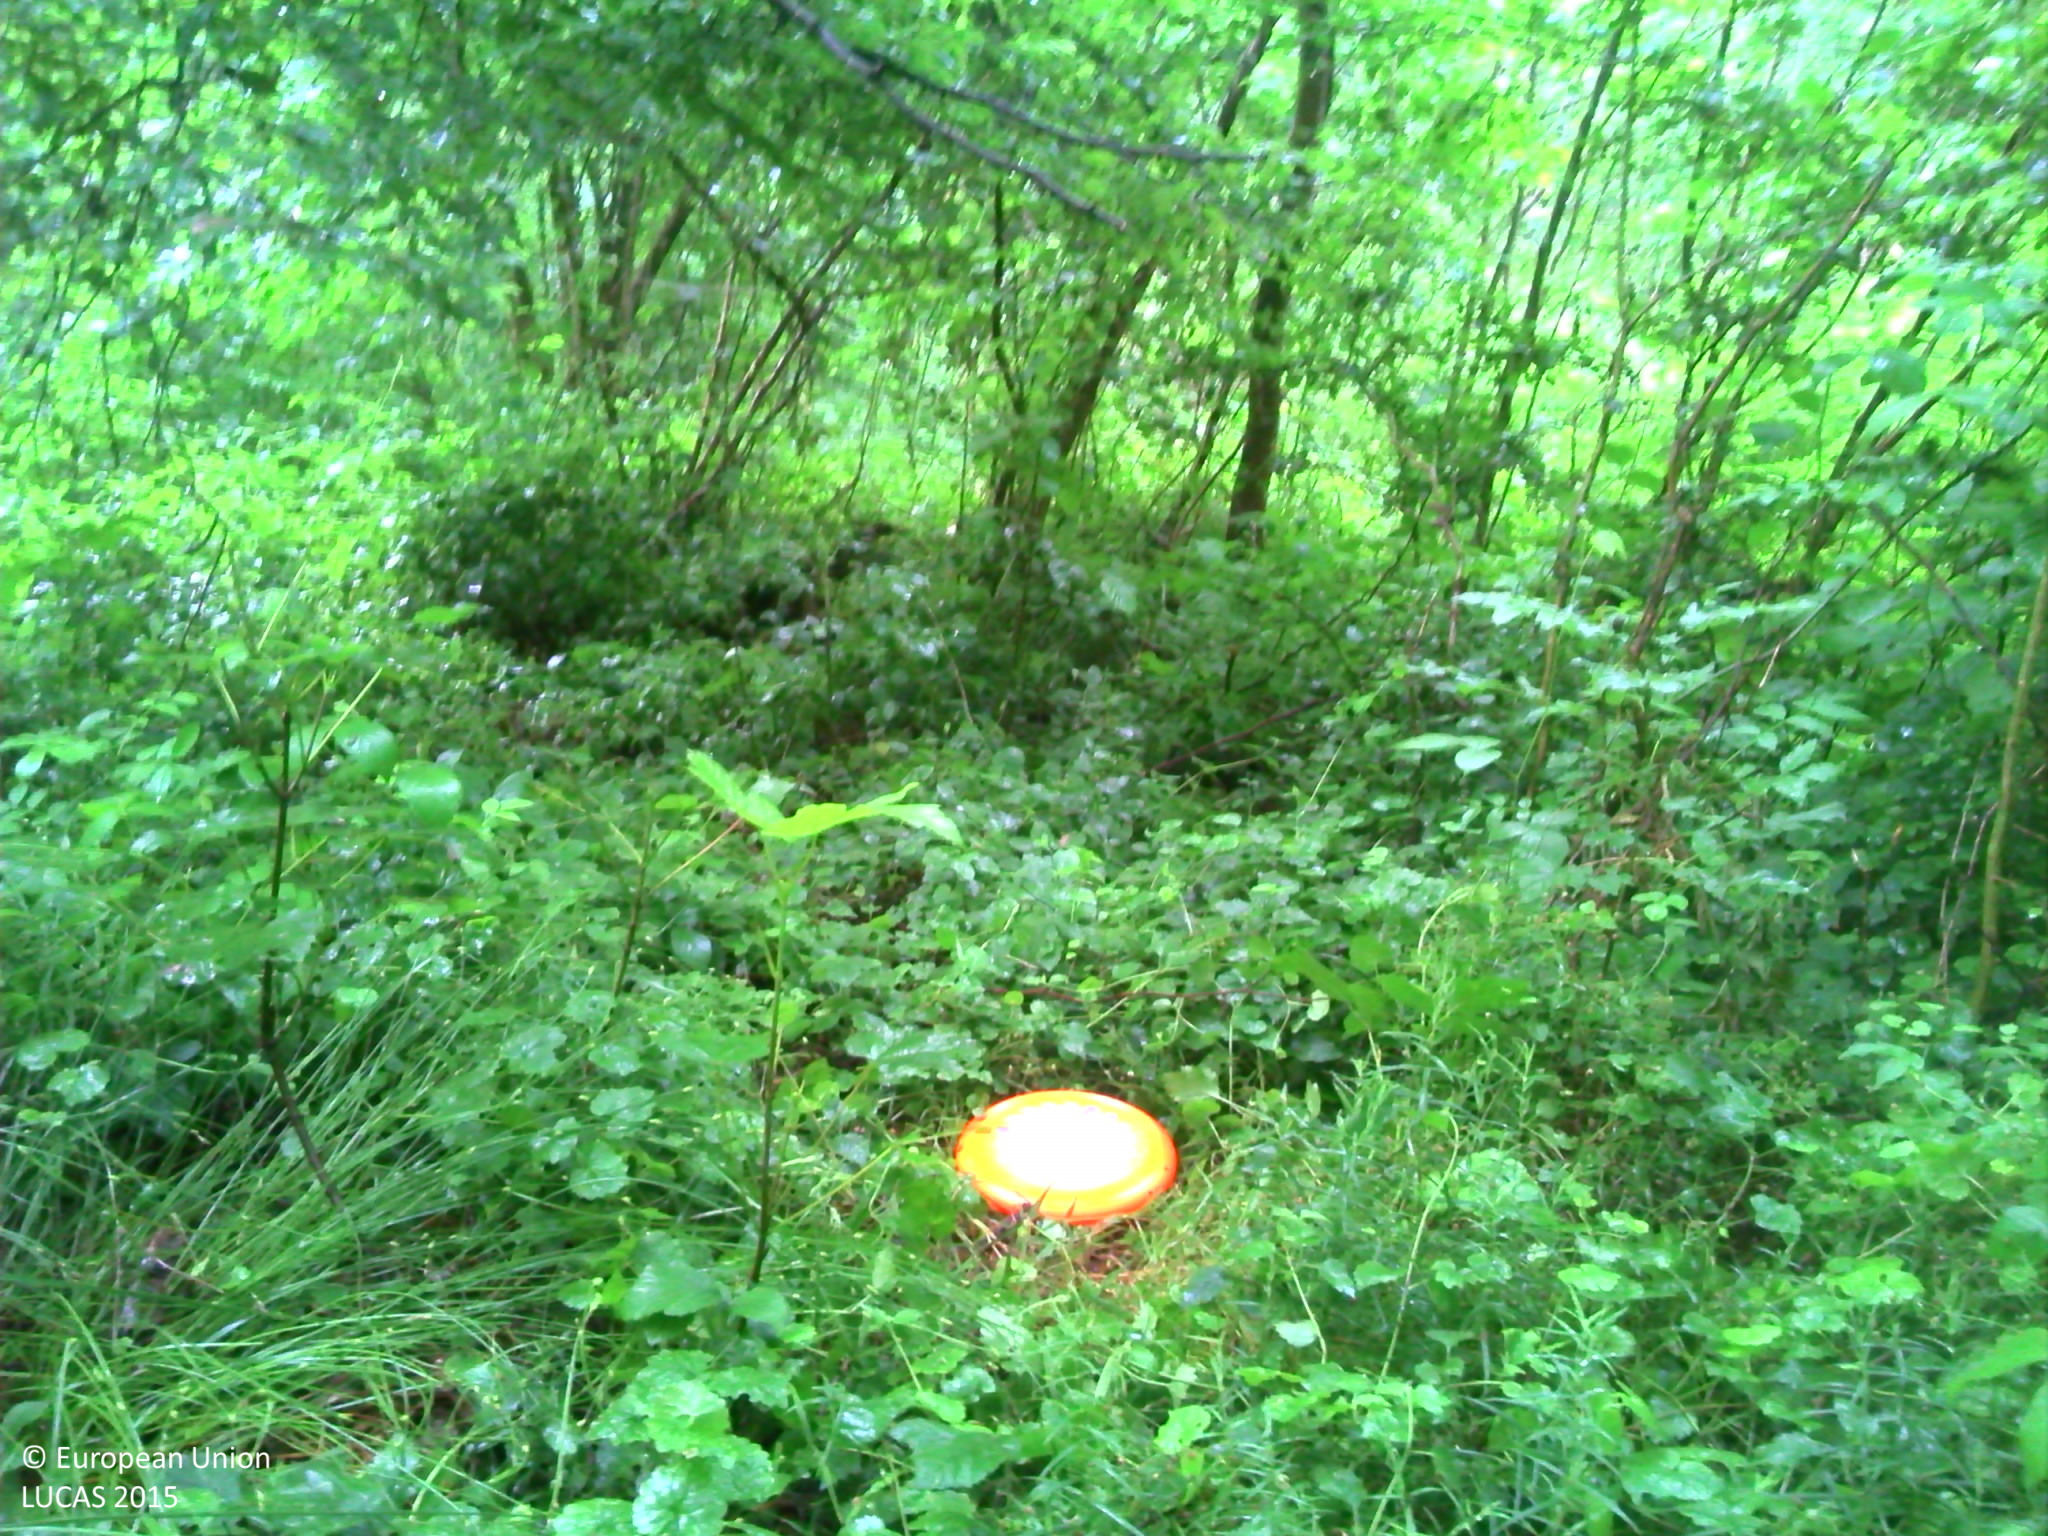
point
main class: Woodland
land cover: Broadleaved woodland
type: mesophytic deciduous forest
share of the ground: > 75 %
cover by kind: broadleaved forest trees 95 %, herbaceous plants 5 %
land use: Forestry
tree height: > 5 m
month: June
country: FR
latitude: 48.3579
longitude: 7.5312
